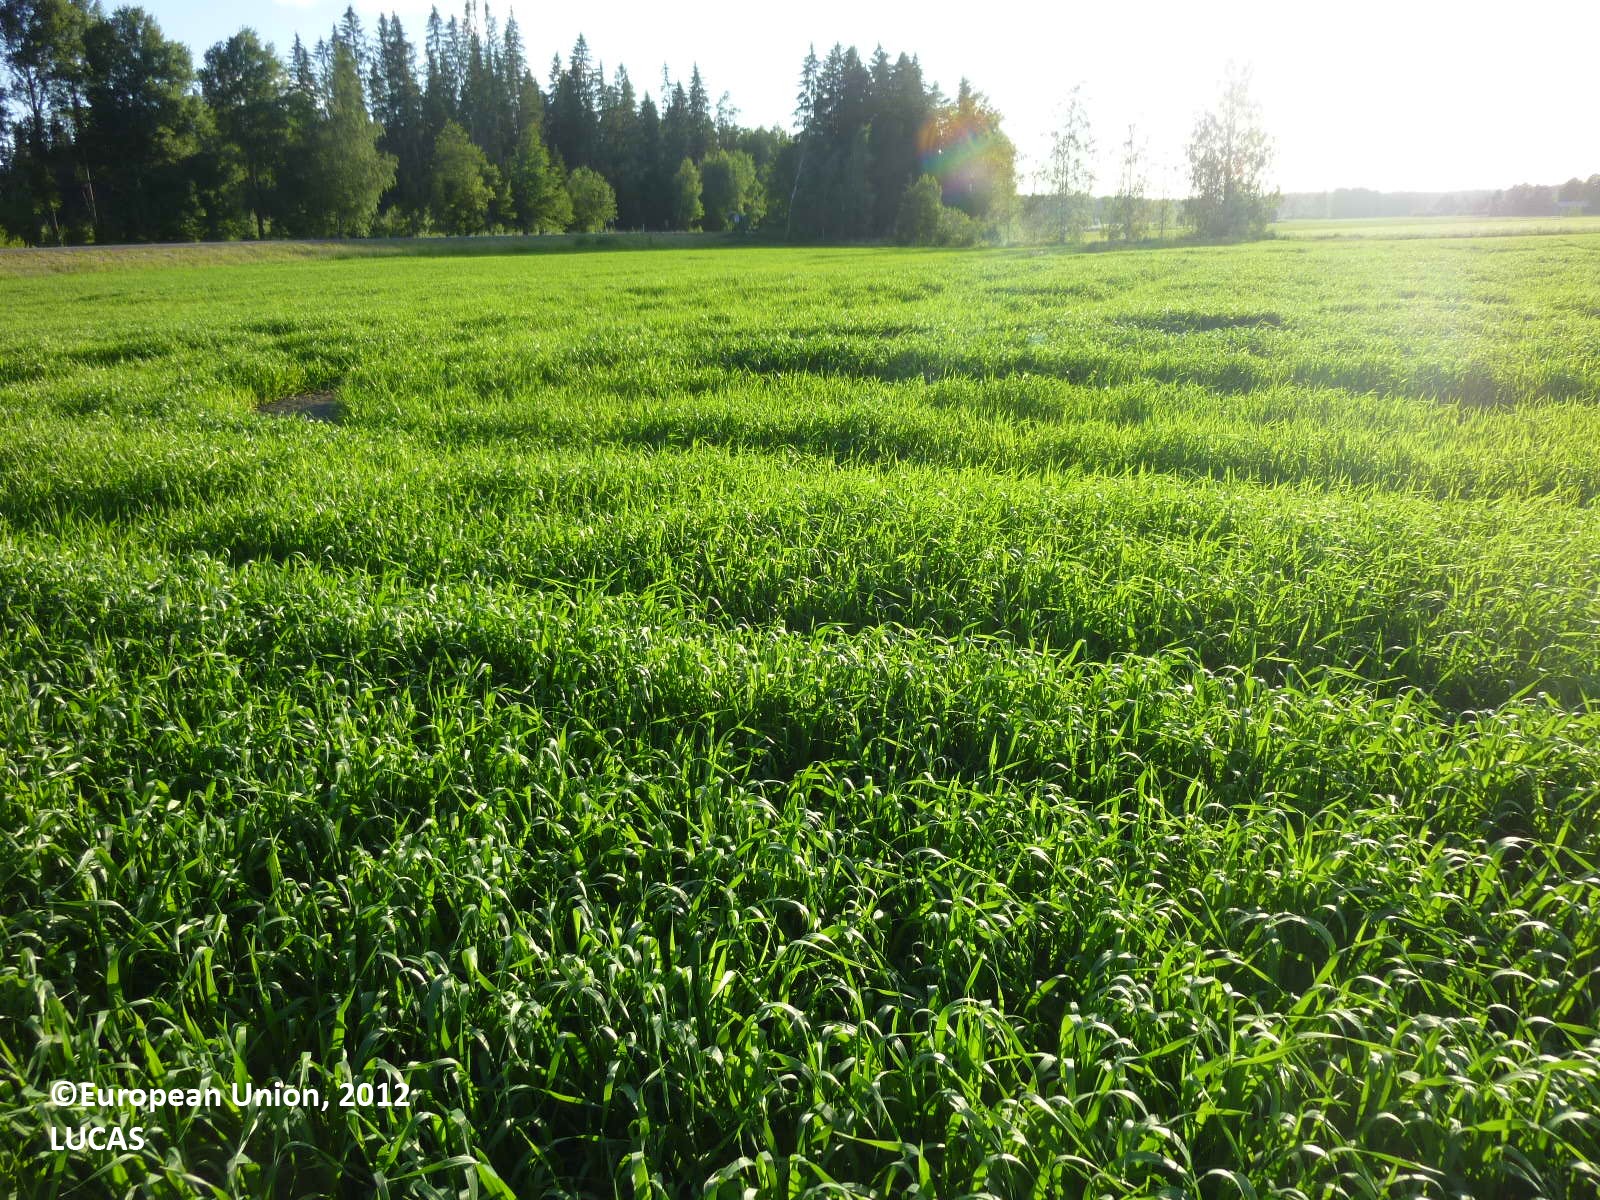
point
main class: Cropland
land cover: Barley
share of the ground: > 75 %
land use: Agriculture (excluding fallow land and kitchen gardens)
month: July
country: FI
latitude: 61.1920
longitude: 22.5113
